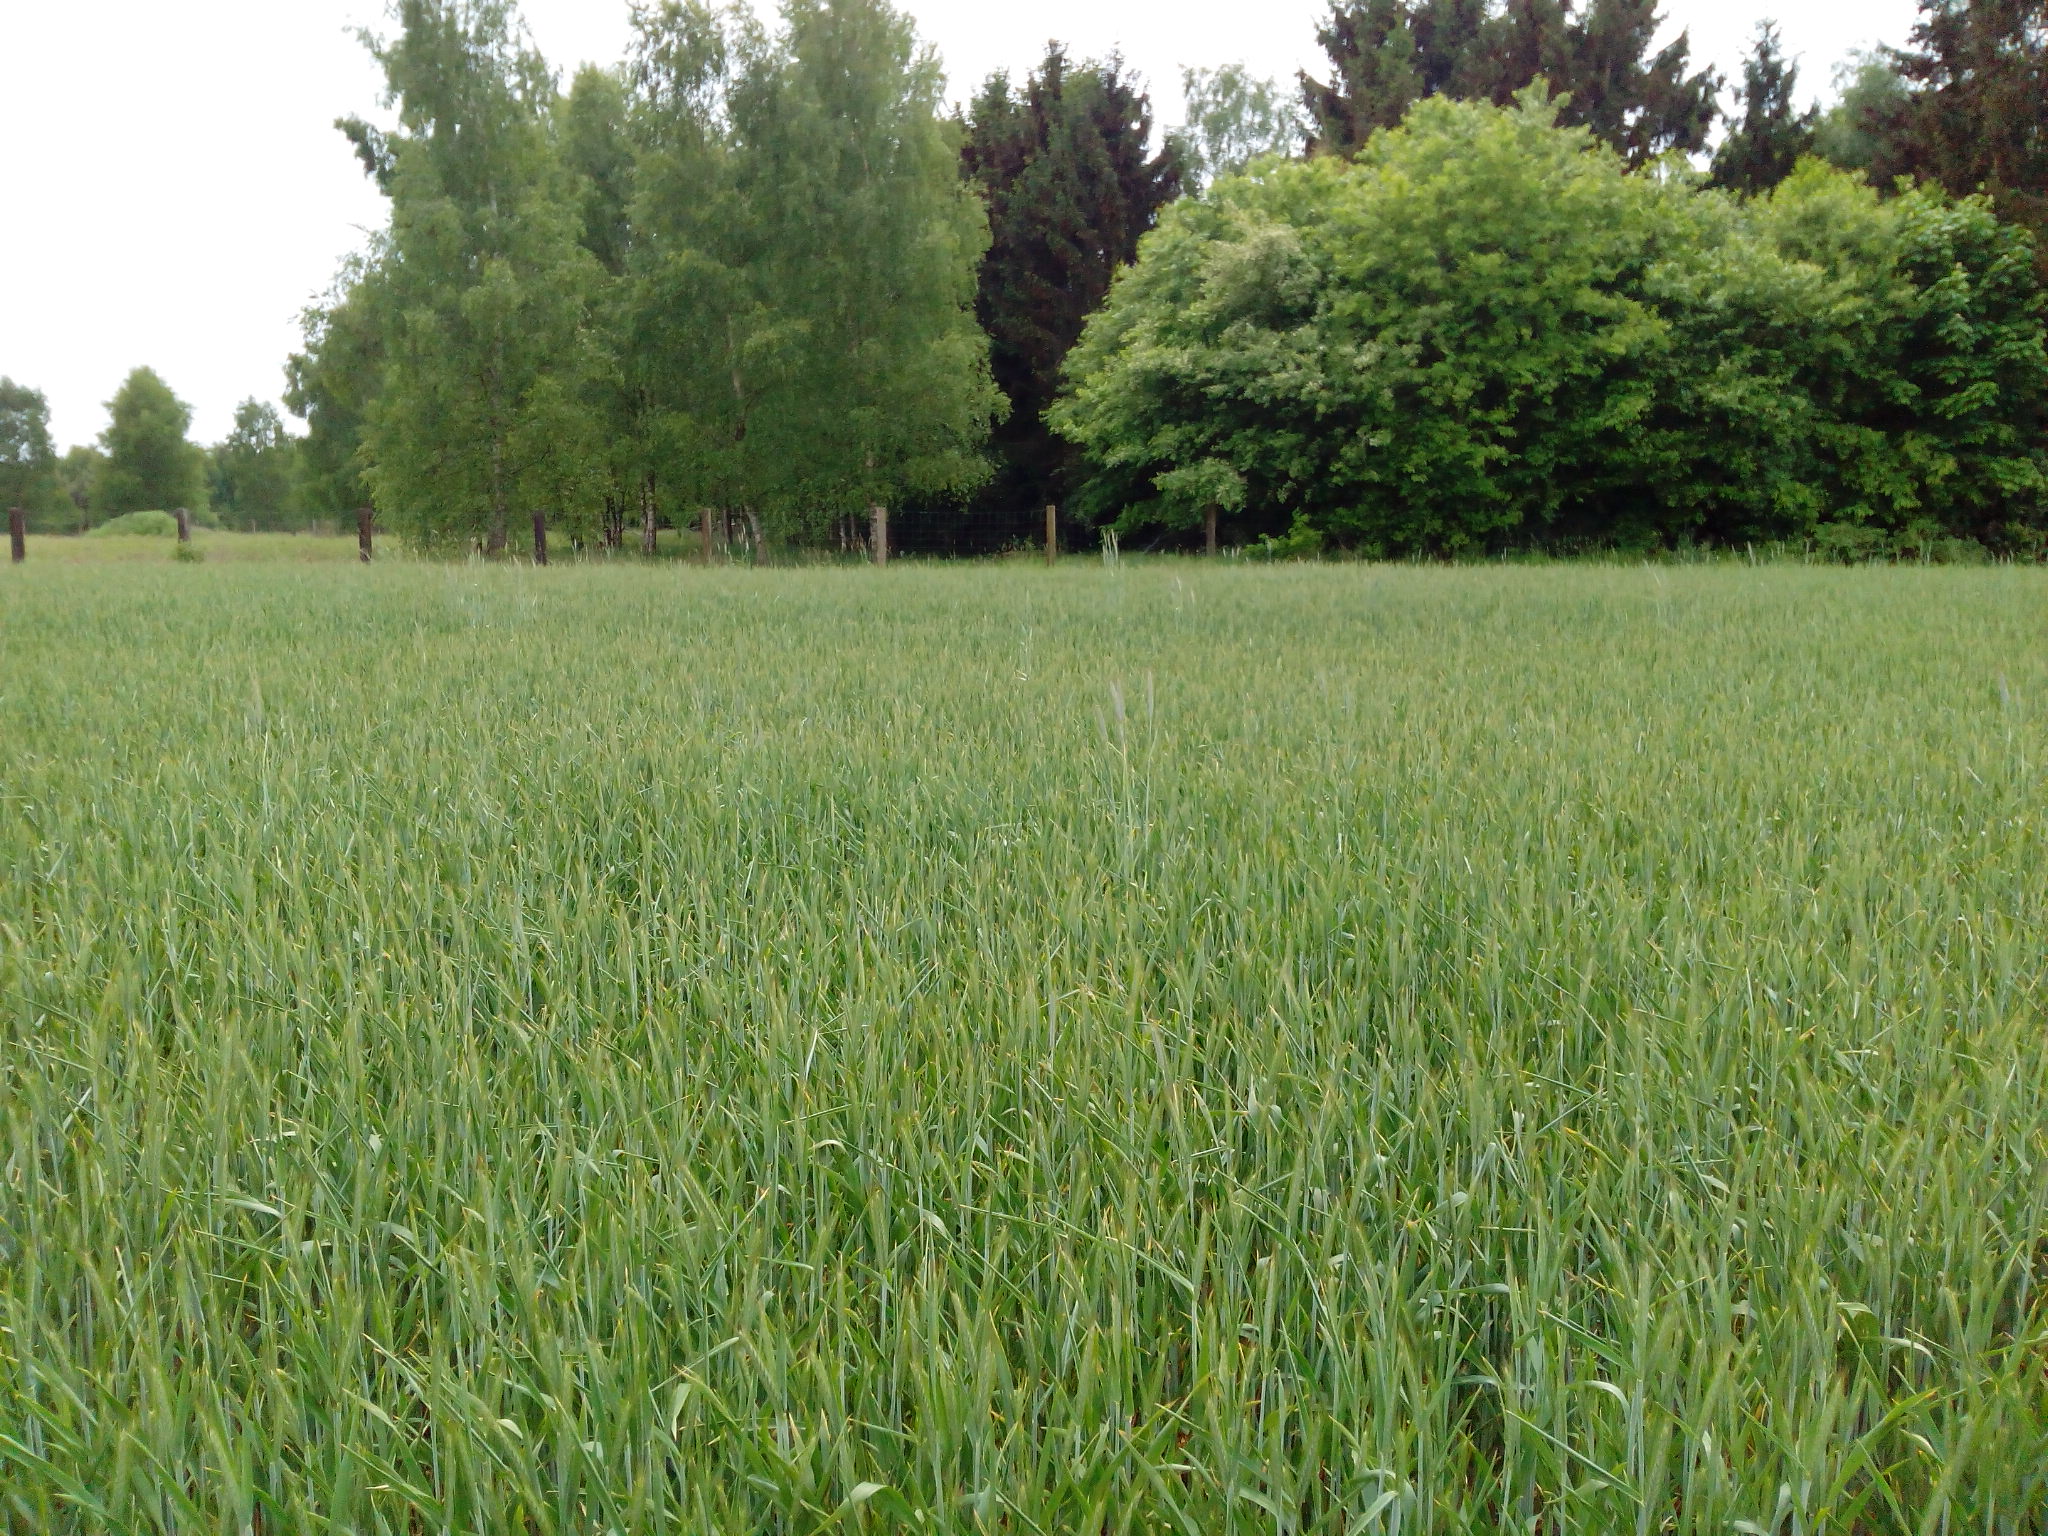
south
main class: Cropland
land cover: Rye
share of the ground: > 75 %
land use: Agriculture (excluding fallow land and kitchen gardens)
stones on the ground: < 10 %
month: June
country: DE
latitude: 52.6830
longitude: 9.8965
